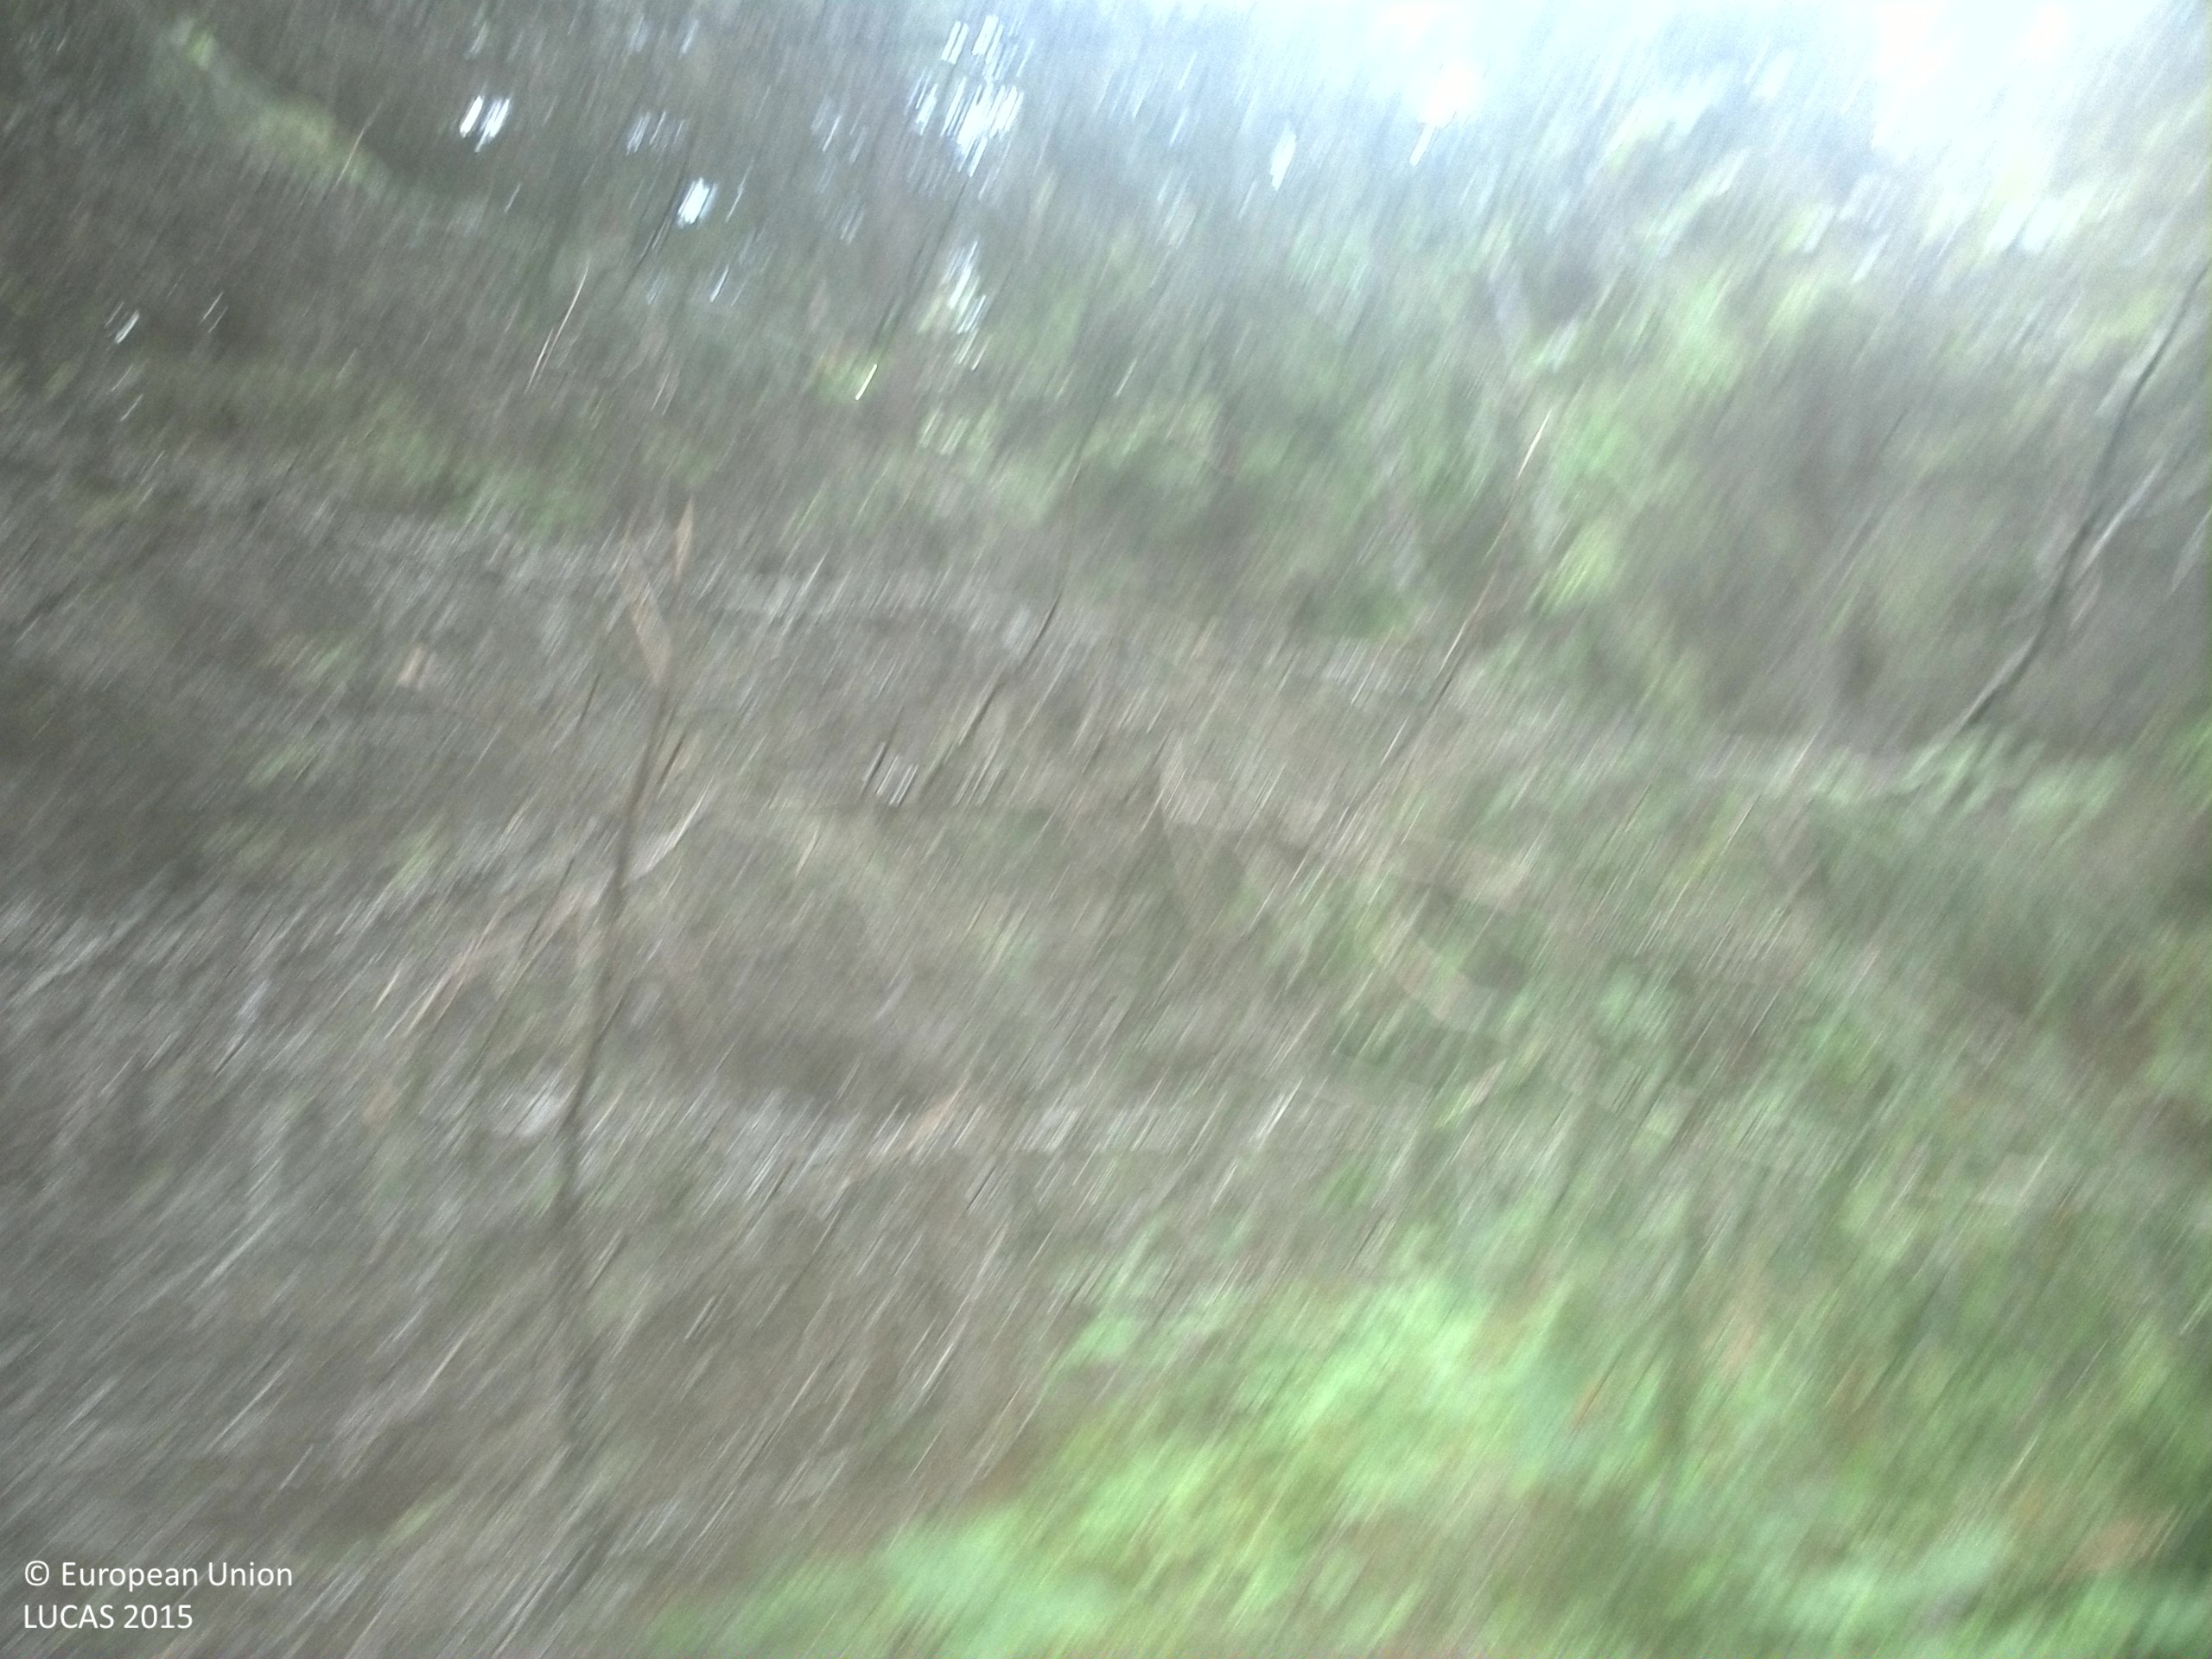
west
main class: Woodland
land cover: Spruce dominated coniferous woodland
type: boreal forest
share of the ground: > 75 %
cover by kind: coniferous forest trees 75 %, shrubs 15 %, broadleaved forest trees 10 %
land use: Forestry
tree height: > 5 m
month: July
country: SE
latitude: 63.5842
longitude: 18.5785
